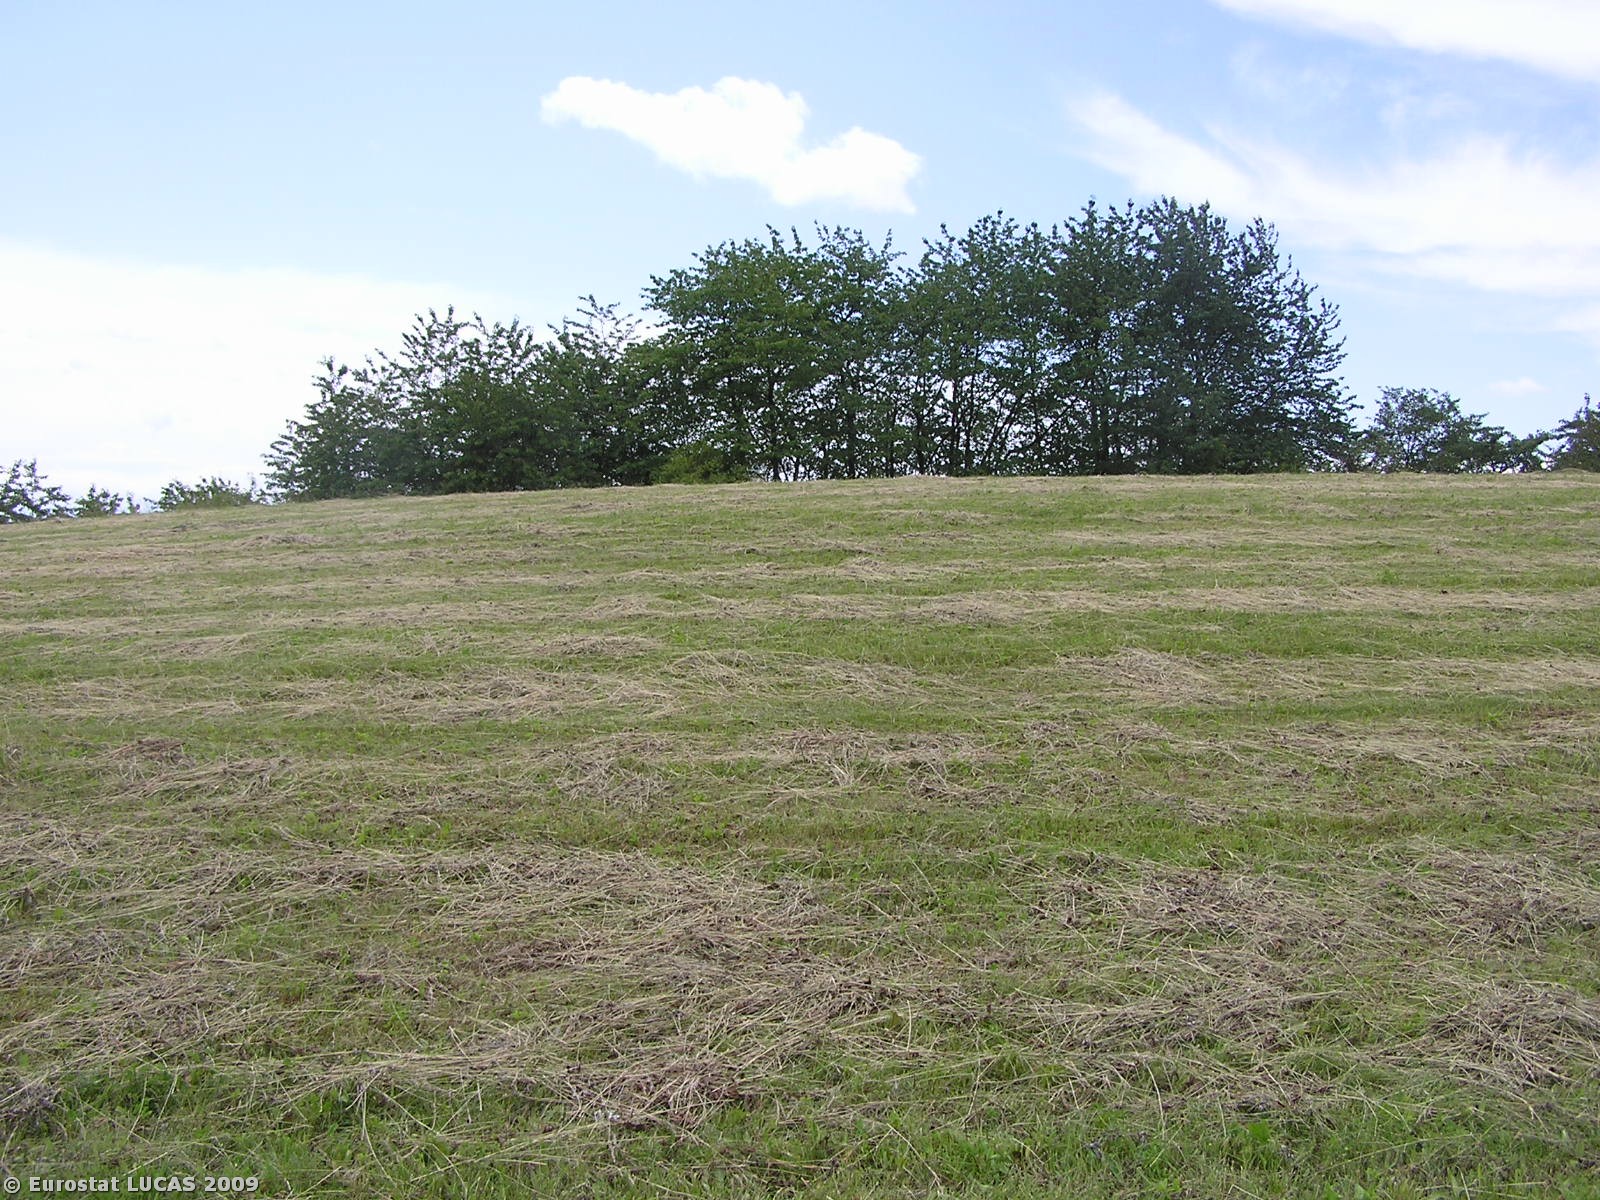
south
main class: Grassland
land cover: Grassland without tree/shrub cover
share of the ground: > 75 %
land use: Agriculture (excluding fallow land and kitchen gardens)
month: June
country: CZ
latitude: 49.8739
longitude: 14.6355
